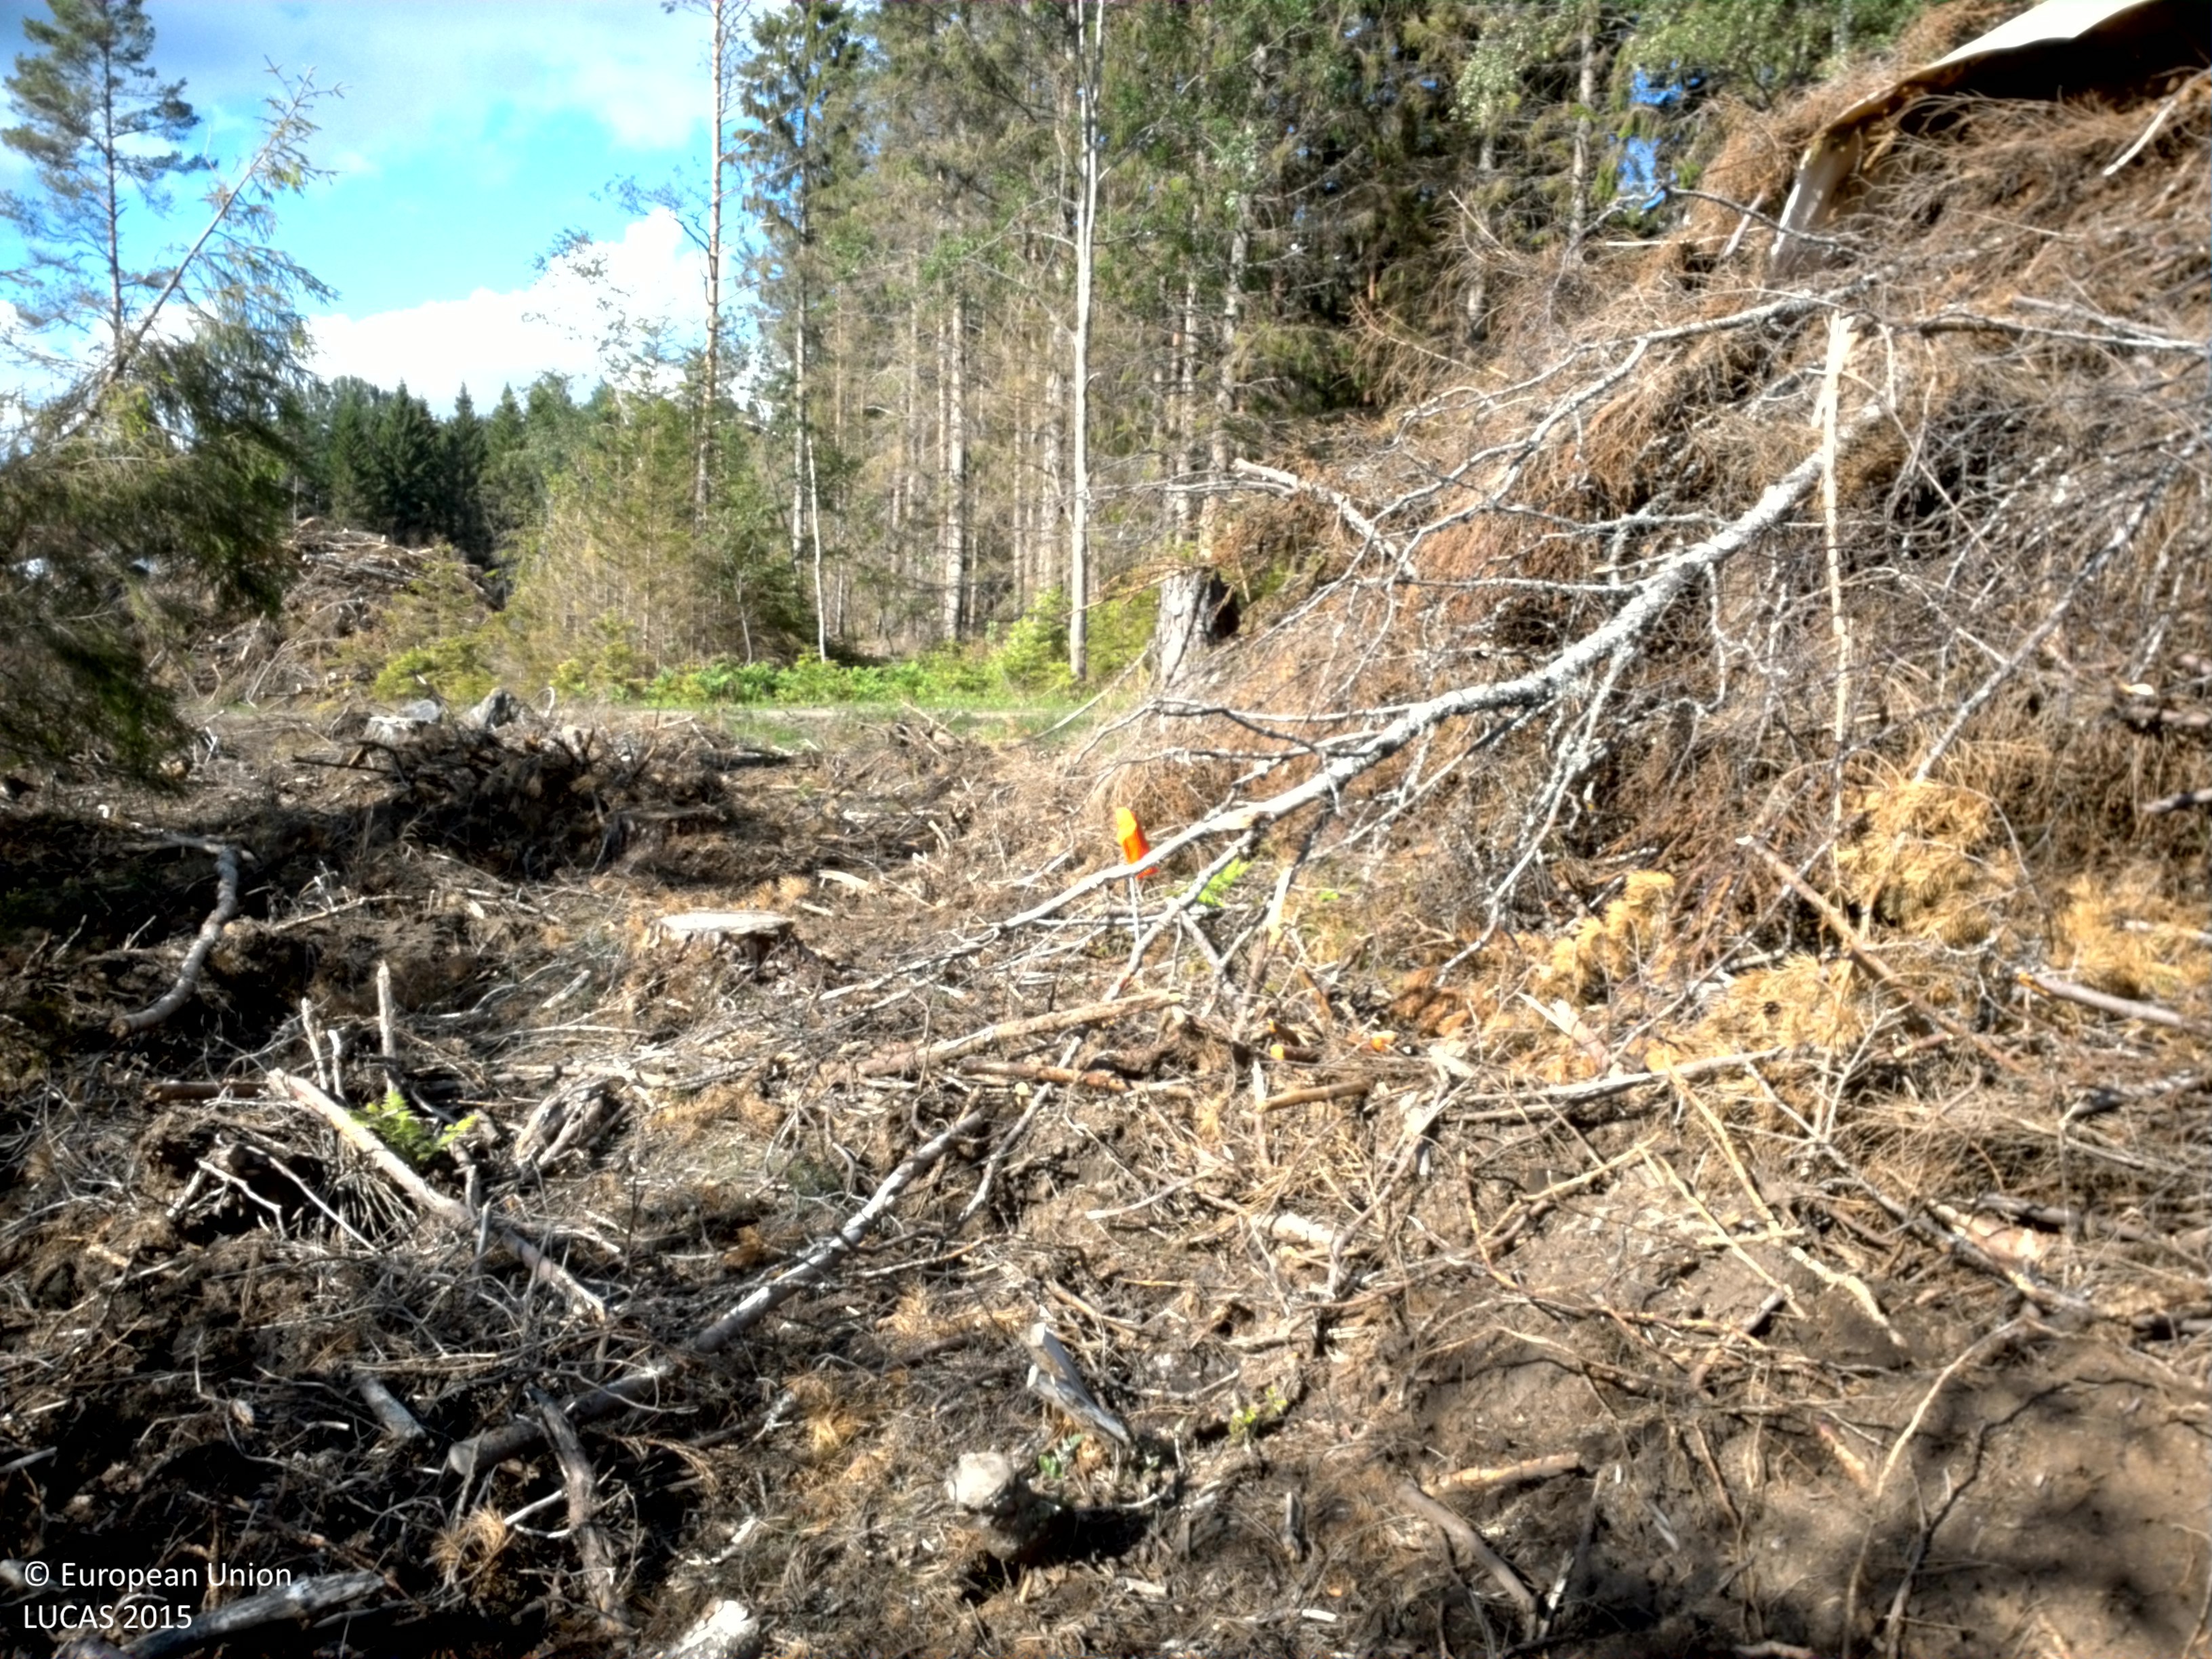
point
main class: Woodland
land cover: Spruce dominated coniferous woodland
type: boreal forest
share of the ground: 10 - 25 %
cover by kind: consolidated bare surface 80 %, coniferous forest trees 10 %, herbaceous plants 10 %
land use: Forestry
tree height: < 5 m
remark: Clear cut
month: June
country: SE
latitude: 58.5725
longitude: 15.5823
